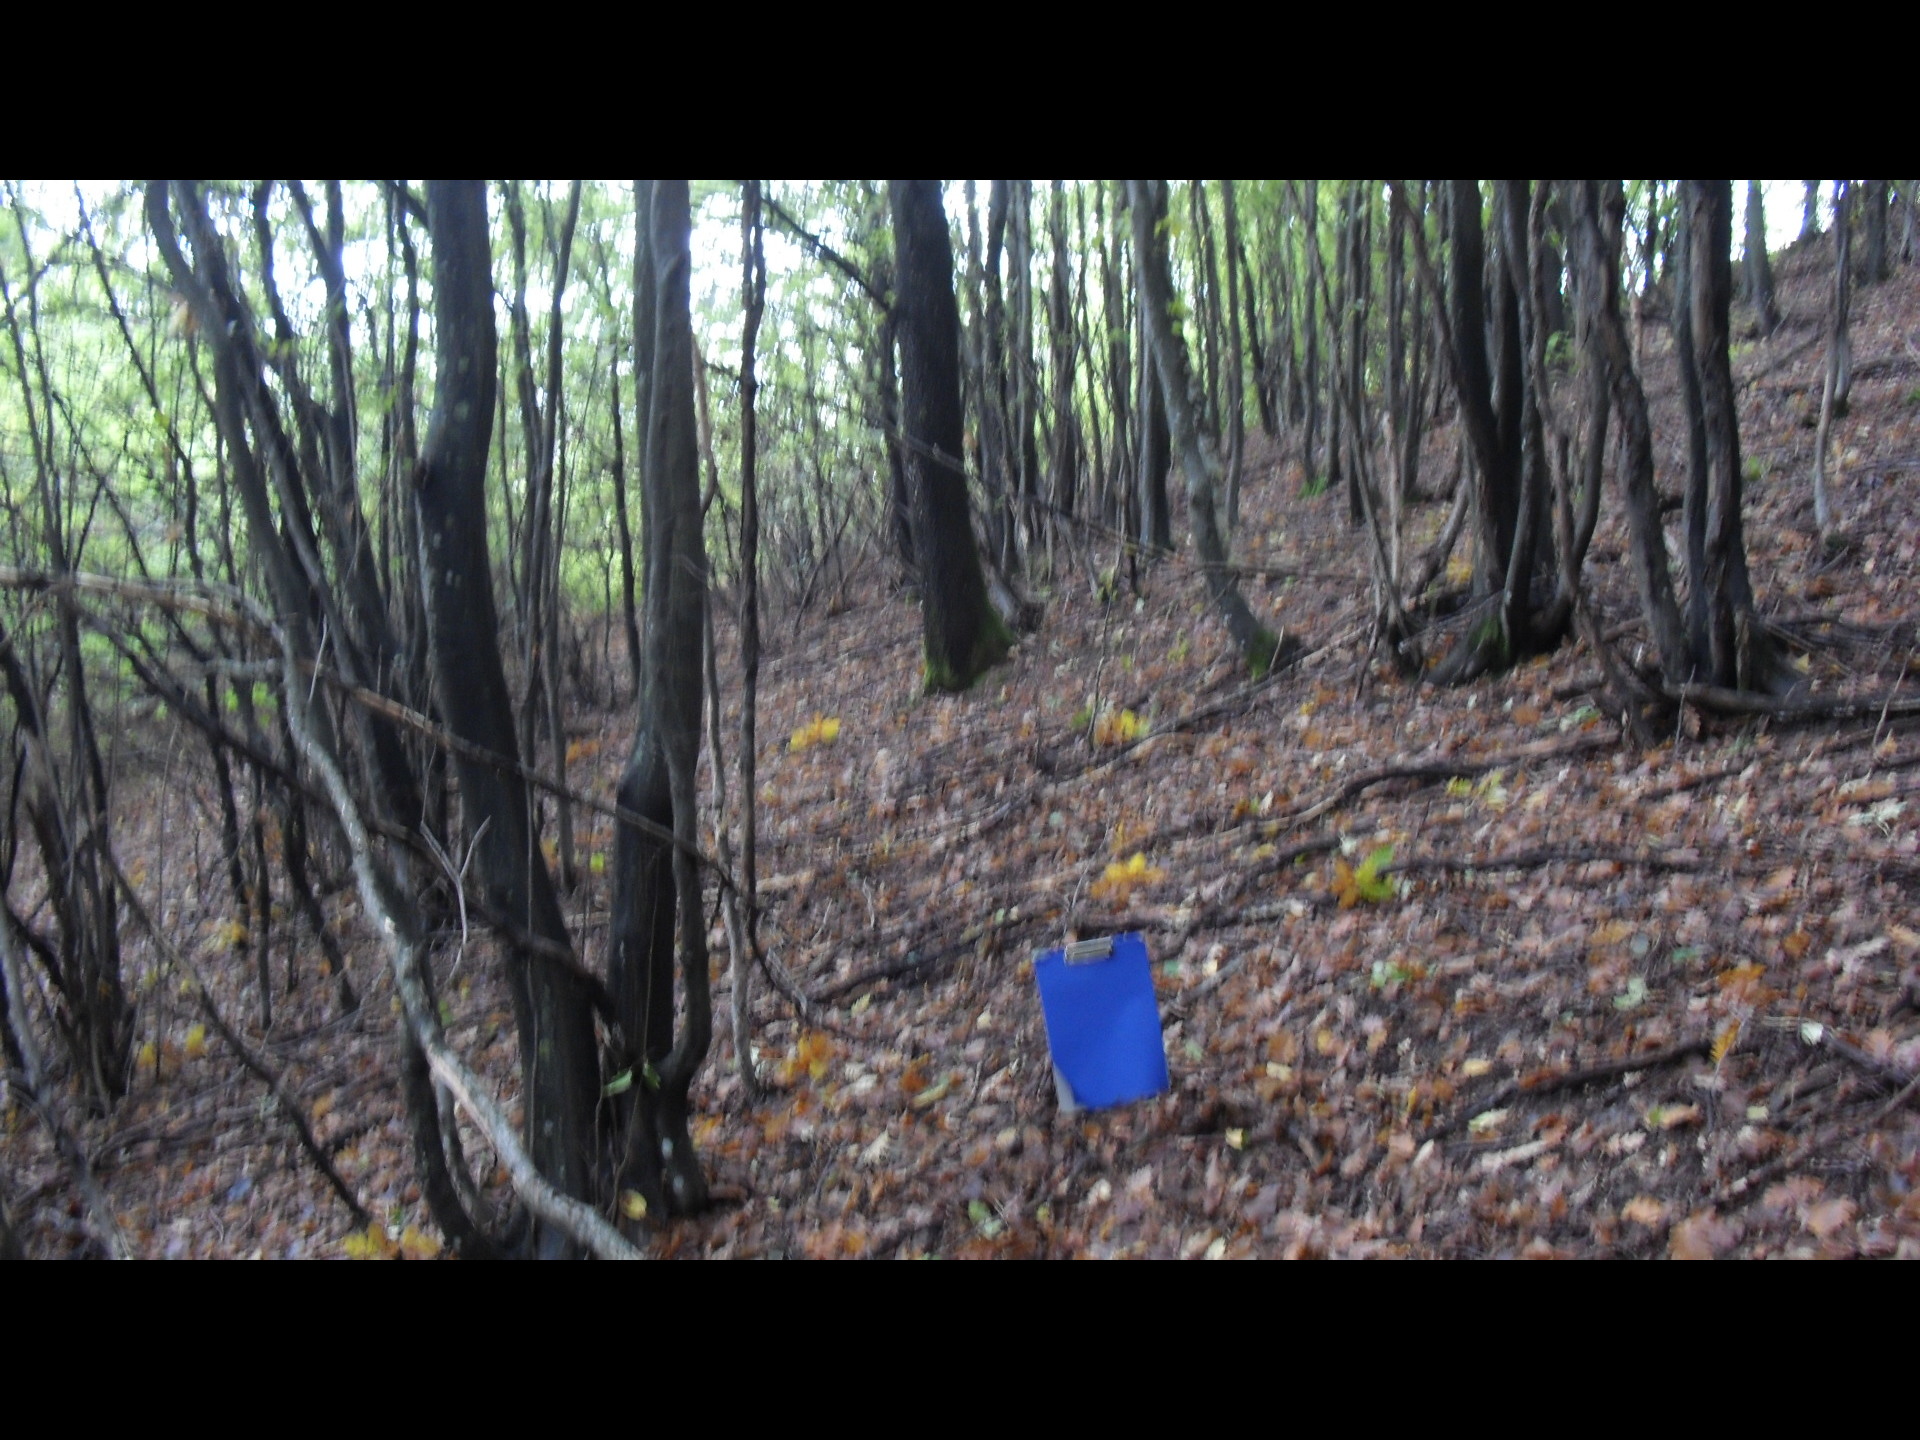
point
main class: Woodland
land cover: Broadleaved woodland
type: mesophytic deciduous forest
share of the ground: > 75 %
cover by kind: broadleaved forest trees 100 %
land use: Forestry
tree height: > 5 m
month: October
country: BG
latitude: 43.4836
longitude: 22.7814
